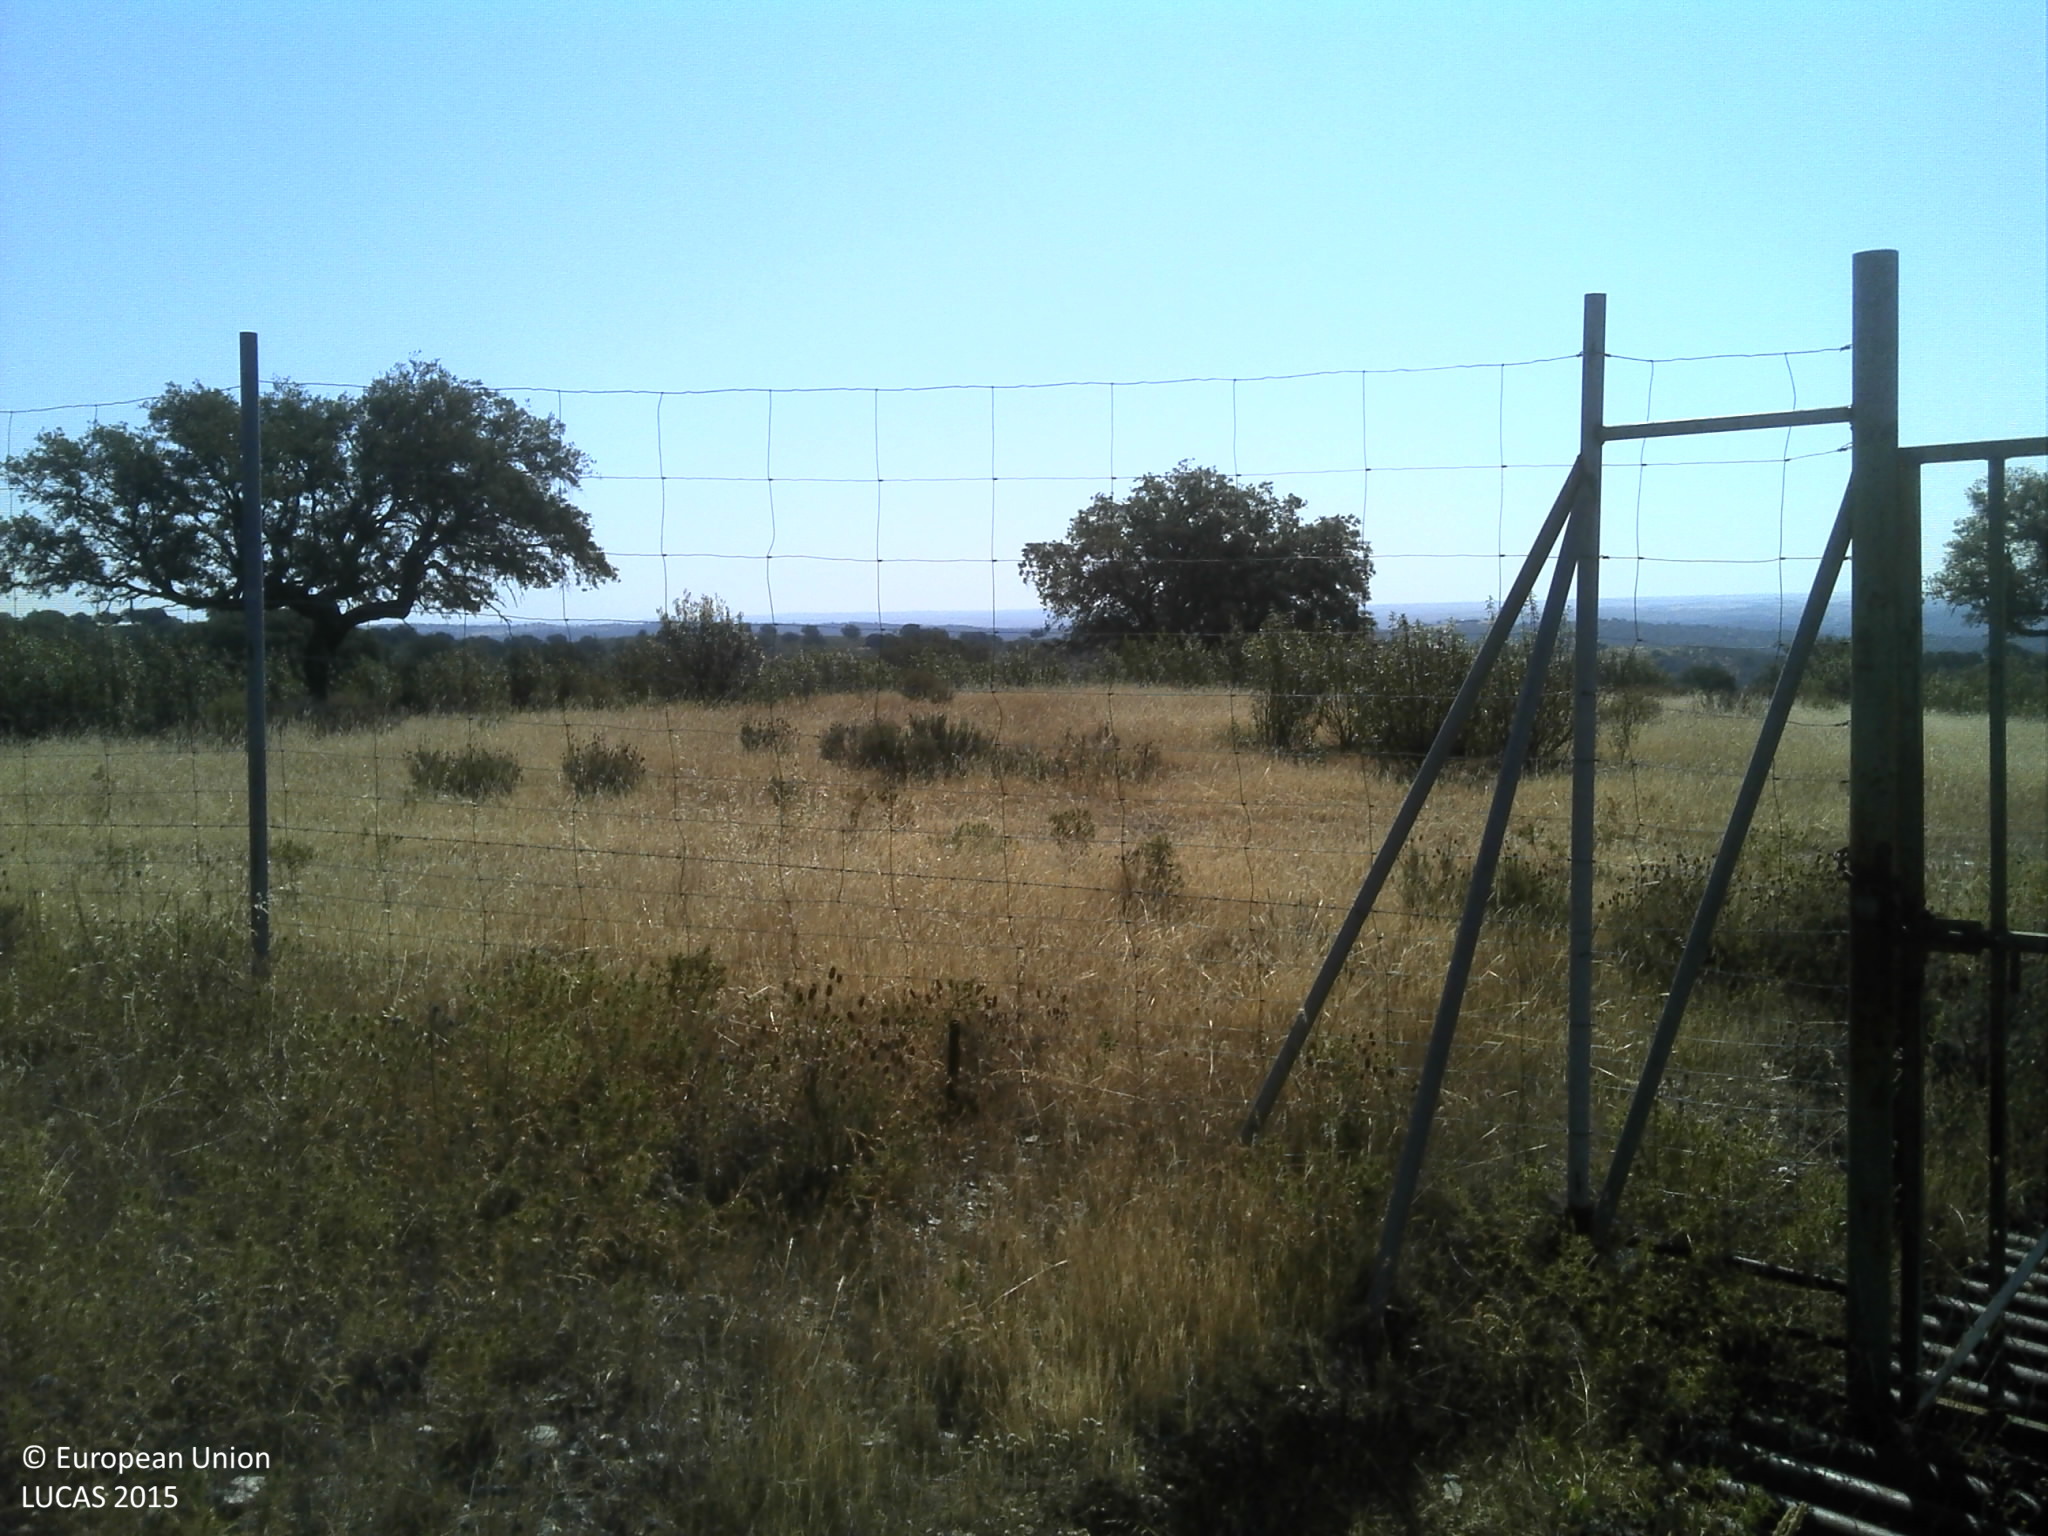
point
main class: Woodland
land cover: Broadleaved woodland
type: broadleaved evergreen forest
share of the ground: 25 - 50 %
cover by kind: shrubs 45 %, broadleaved forest trees 30 %, herbaceous plants 15 %, unconsolidated bare surface 5 %
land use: Forestry
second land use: Other primary production
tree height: > 5 m
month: June
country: PT
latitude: 39.6884
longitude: -7.0284
